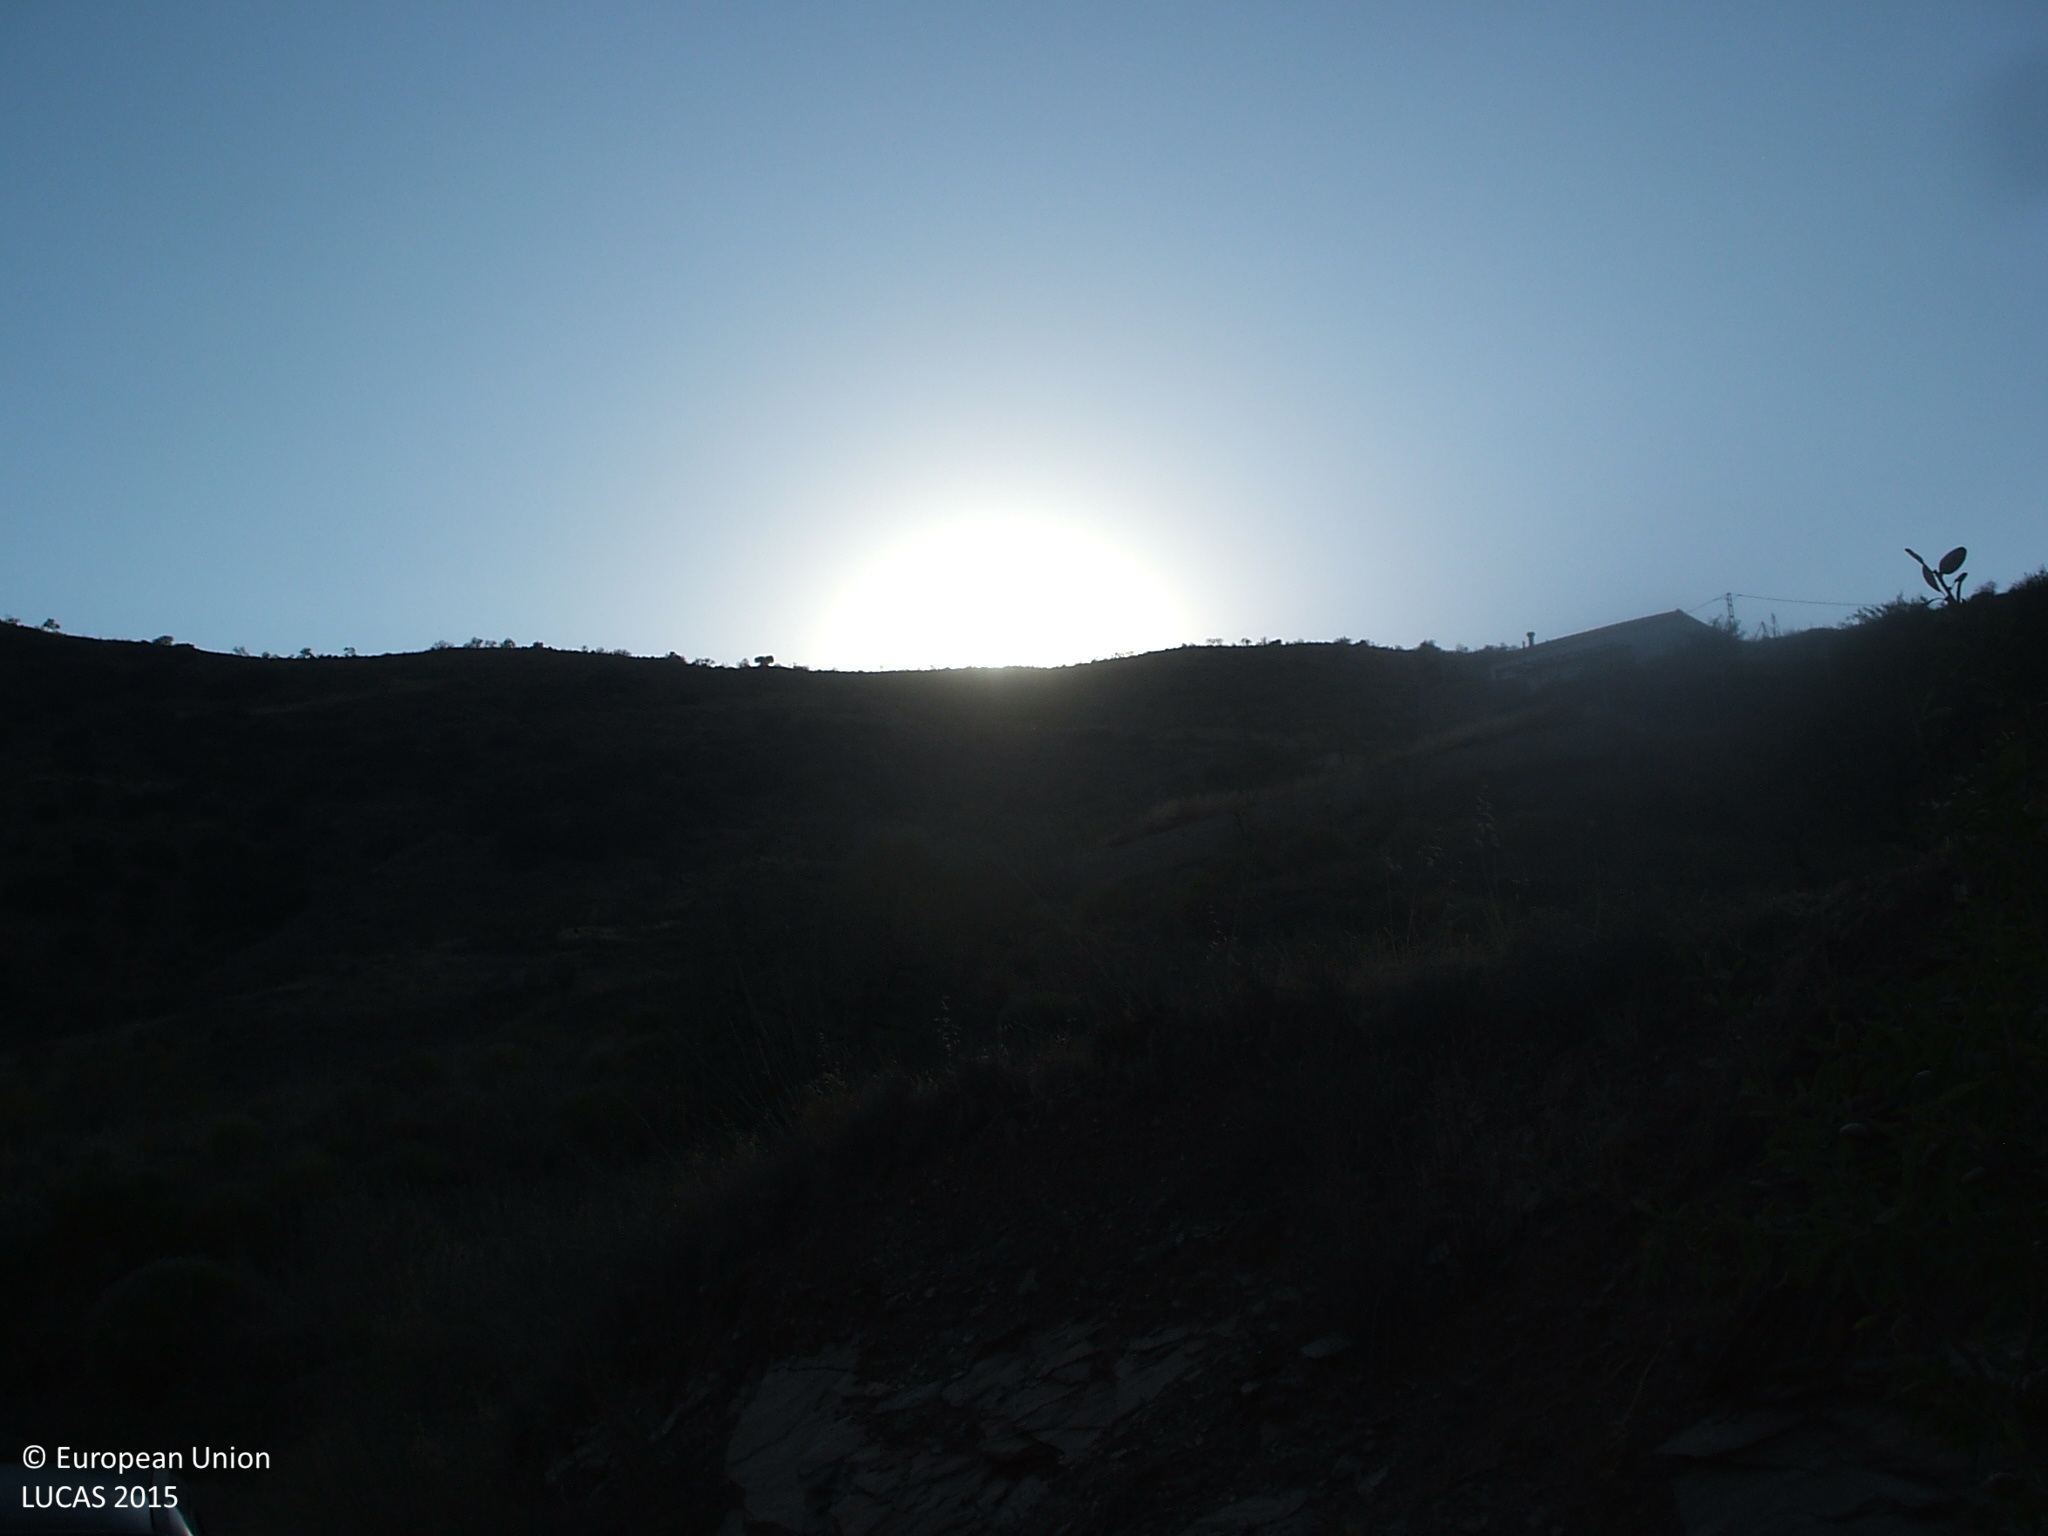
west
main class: Cropland
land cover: Nuts trees
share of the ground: 10 - 25 %
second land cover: Other bare soil
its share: > 75 %
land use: Agriculture (excluding fallow land and kitchen gardens)
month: July
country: ES
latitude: 36.7851
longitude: -3.0778
